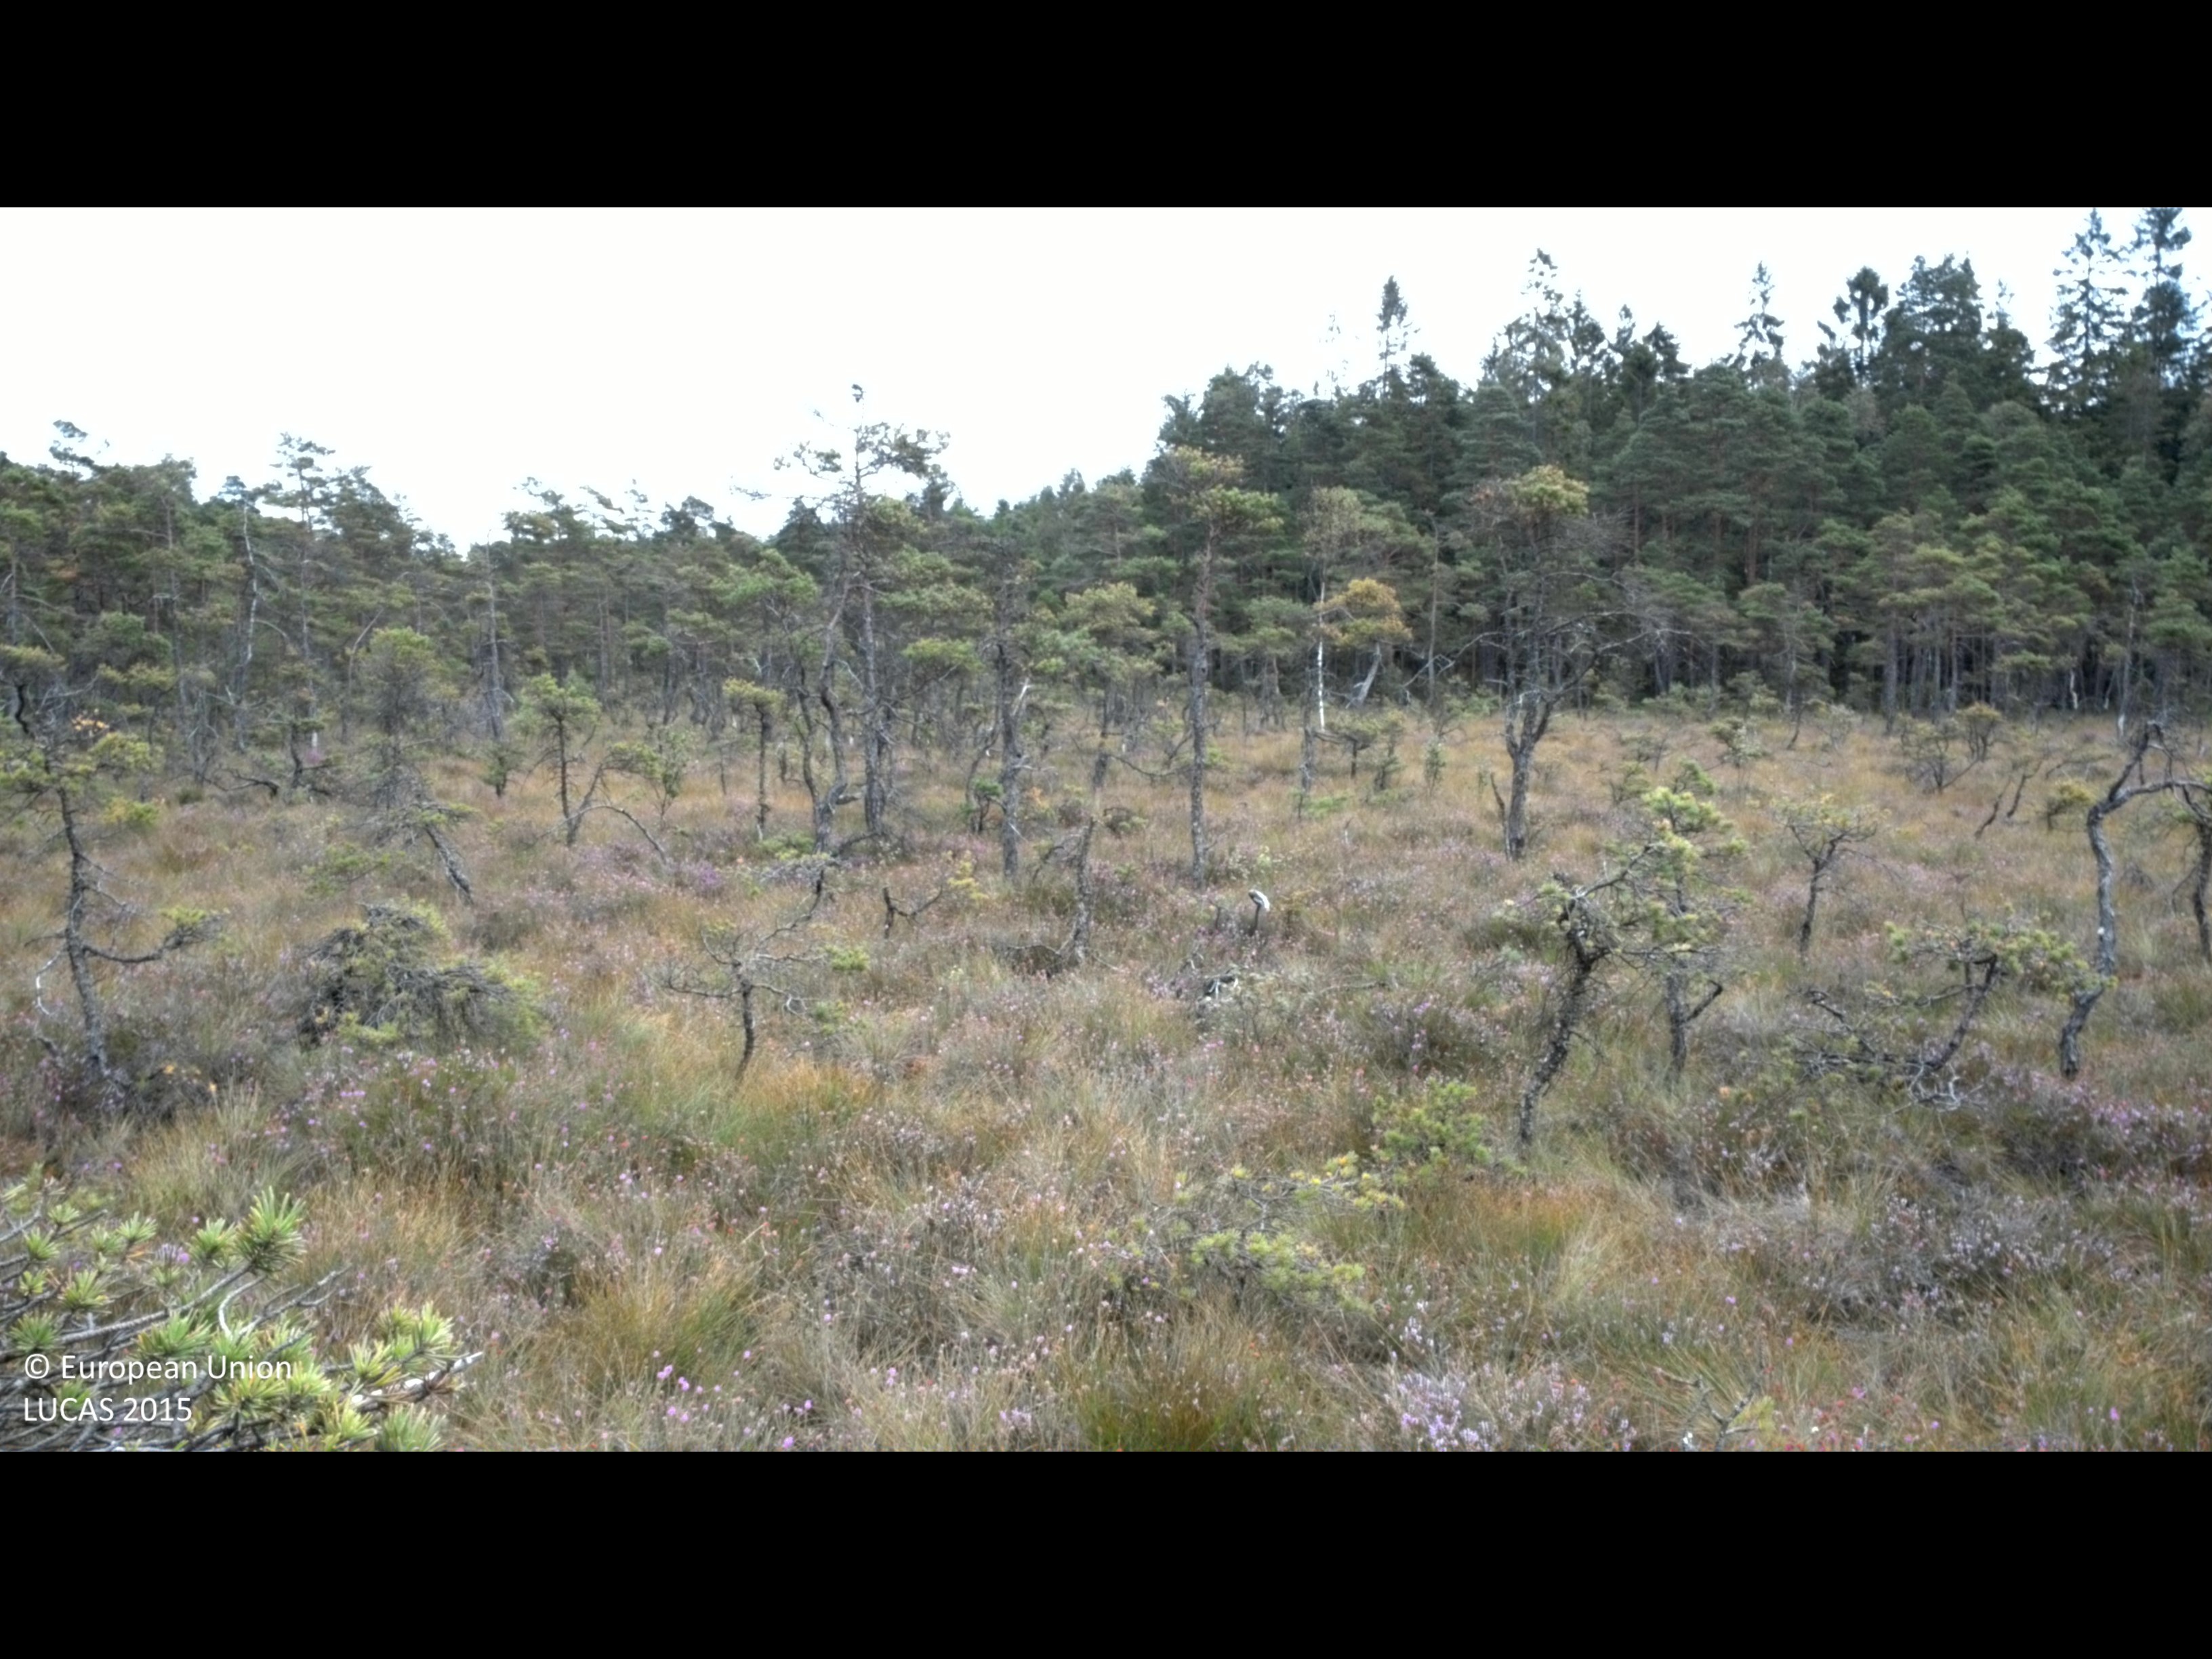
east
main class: Woodland
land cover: Pine dominated coniferous woodland
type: mire and swamp forests
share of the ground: 25 - 50 %
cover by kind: coniferous forest trees 40 %, shrubs 30 %, herbaceous plants 30 %
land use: Semi-natural and natural areas not in use
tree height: < 5 m
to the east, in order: Pine dominated coniferous woodland; Spruce dominated coniferous woodland; Tracks; Spruce dominated coniferous woodland
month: August
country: SE
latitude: 56.8677
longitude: 13.1954
